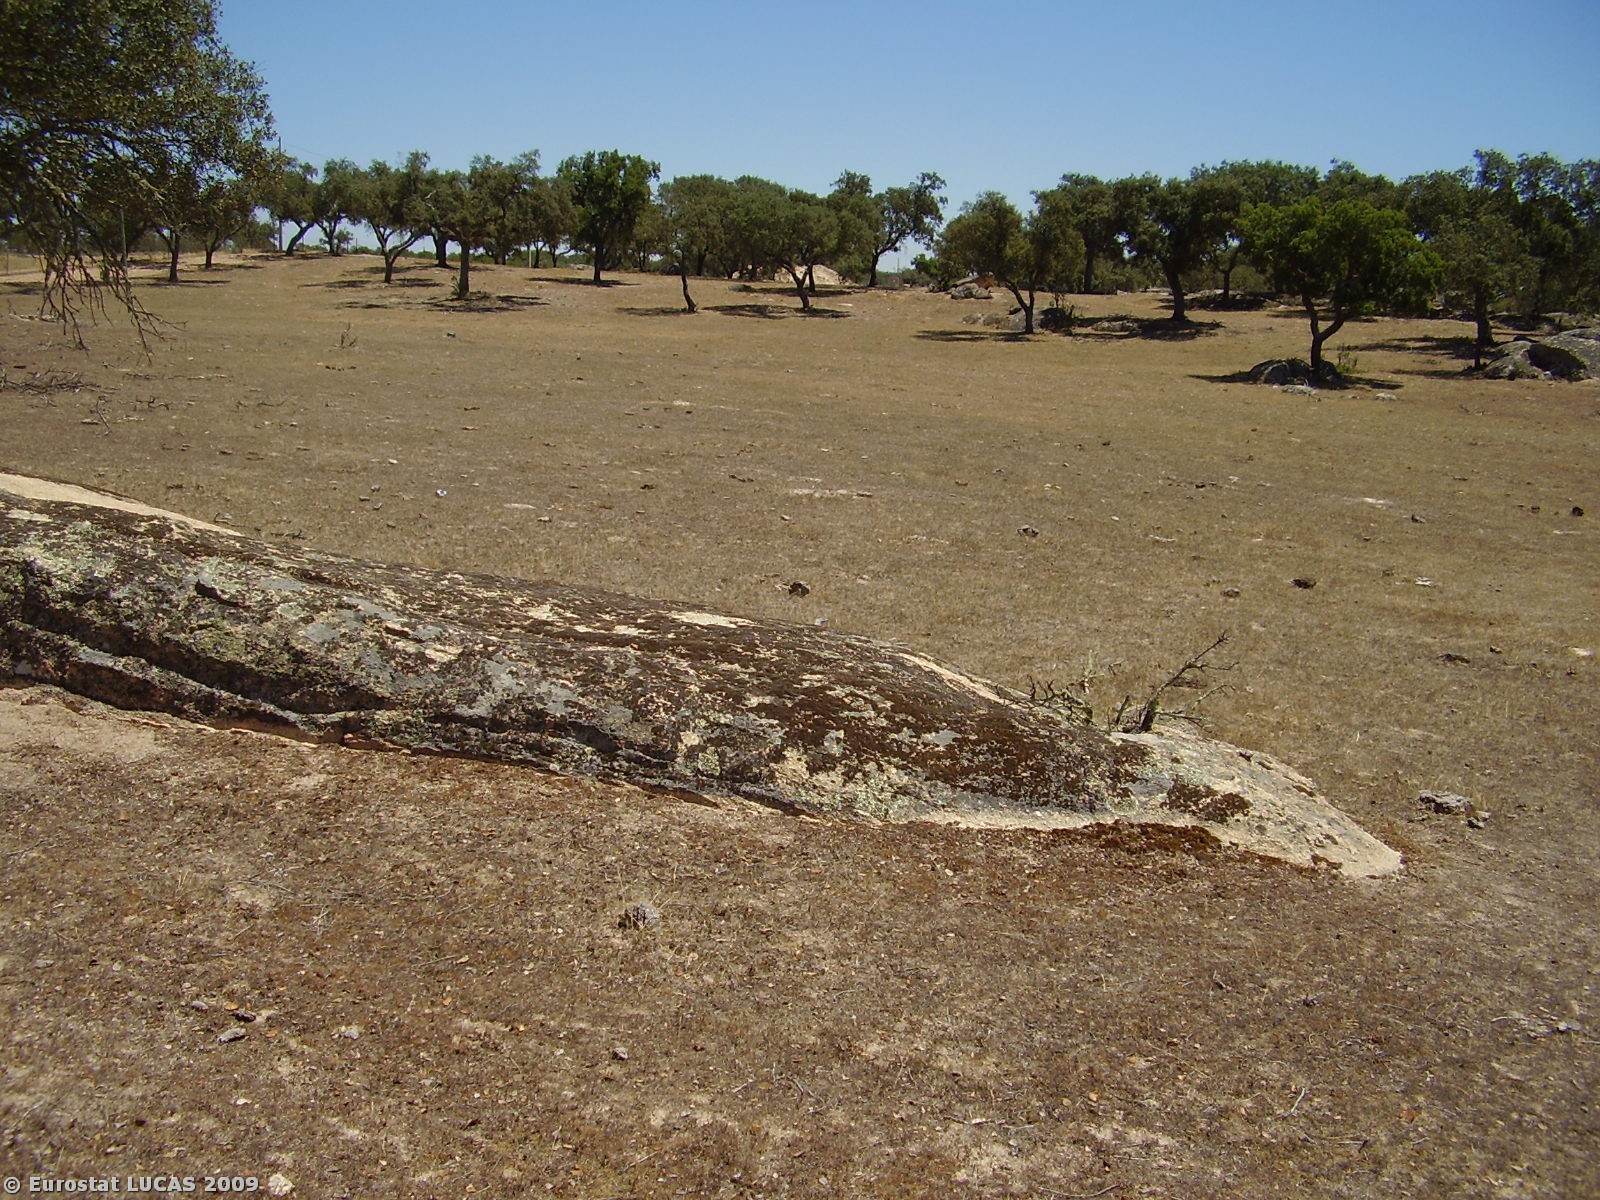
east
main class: Woodland
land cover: Broadleaved woodland
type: broadleaved evergreen forest
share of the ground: 10 - 25 %
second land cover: Grassland with sparse tree/shrub cover
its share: 50 - 75 %
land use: Forestry
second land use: Fallow land
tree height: > 5 m
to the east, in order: Broadleaved woodland; Grassland with sparse tree/shrub cover; Broadleaved woodland; Rock outcrops; Grassland without tree/shrub cover; Broadleaved woodland; Electric lines; Broadleaved woodland; Fences; Electric lines; Grass margins; Paved roads, cycling and walking lanes; Spontaneously vegetated surfaces; Fences; Spontaneously vegetated surfaces
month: July
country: PT
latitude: 38.8477
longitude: -7.8920
